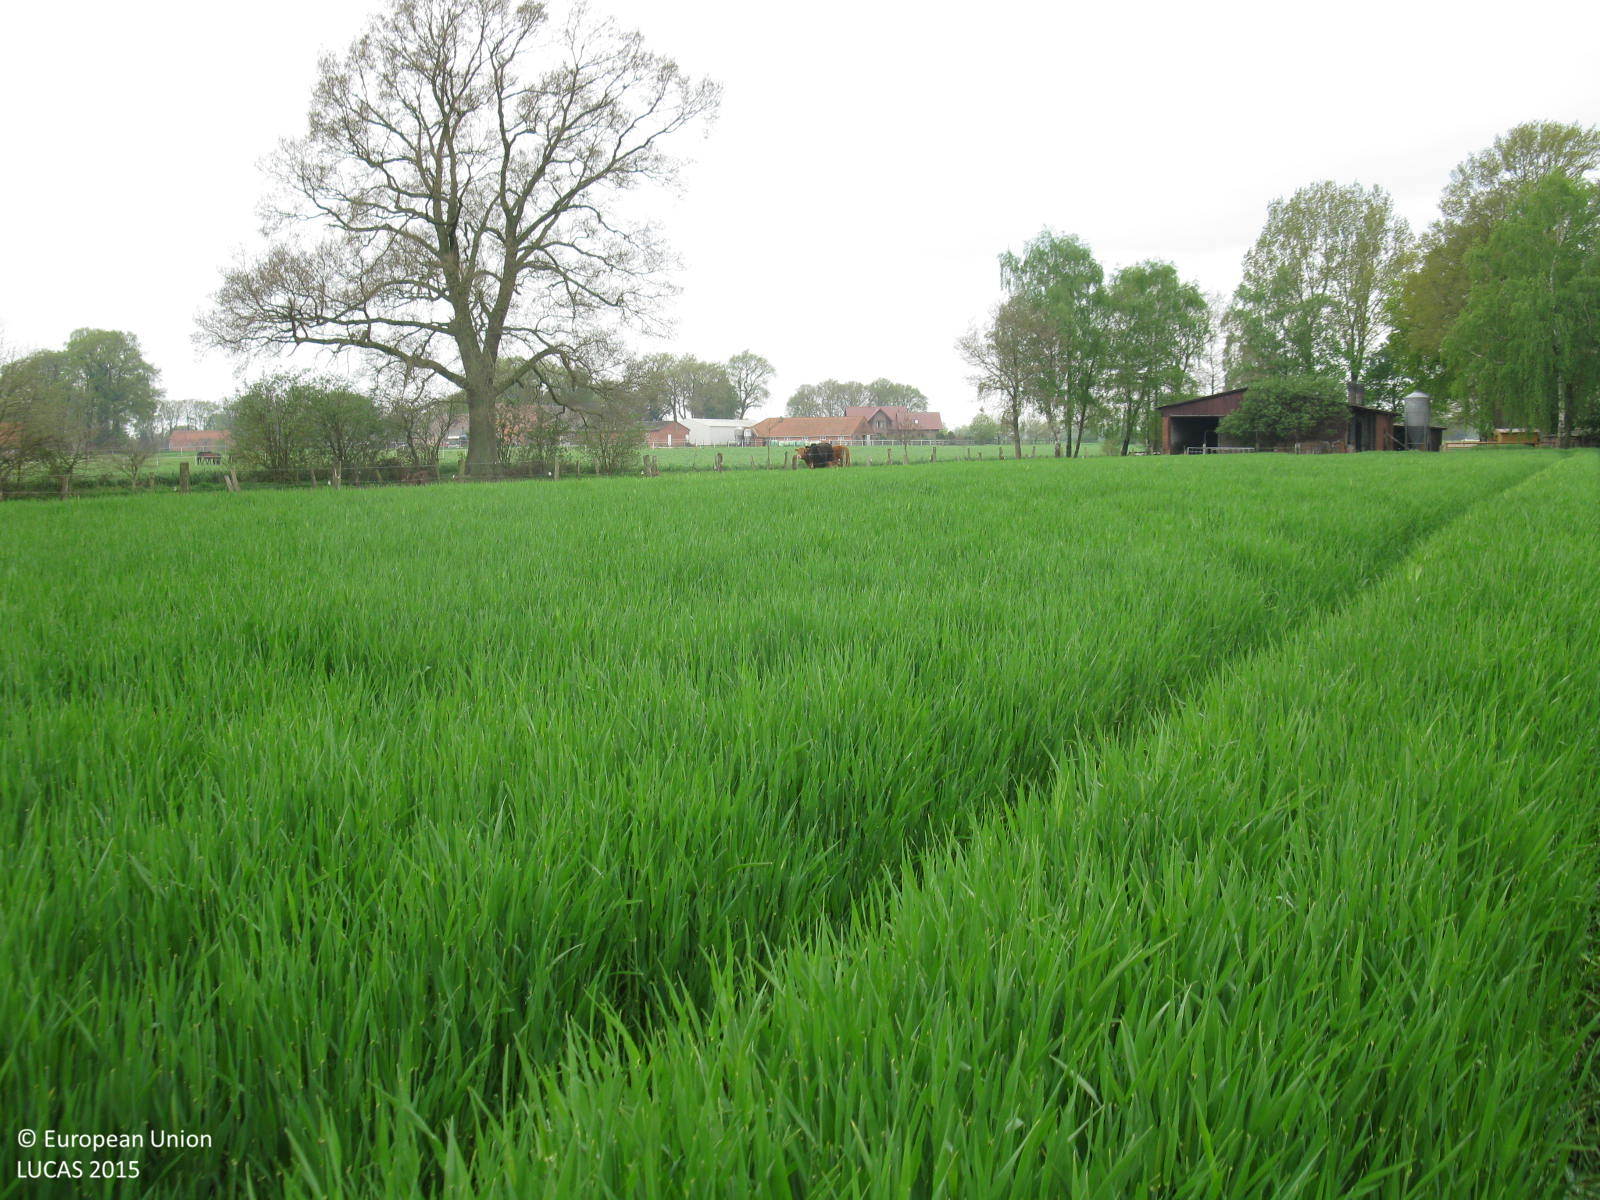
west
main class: Cropland
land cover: Barley
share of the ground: > 75 %
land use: Agriculture (excluding fallow land and kitchen gardens)
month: May
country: DE
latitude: 52.8809
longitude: 7.9351
